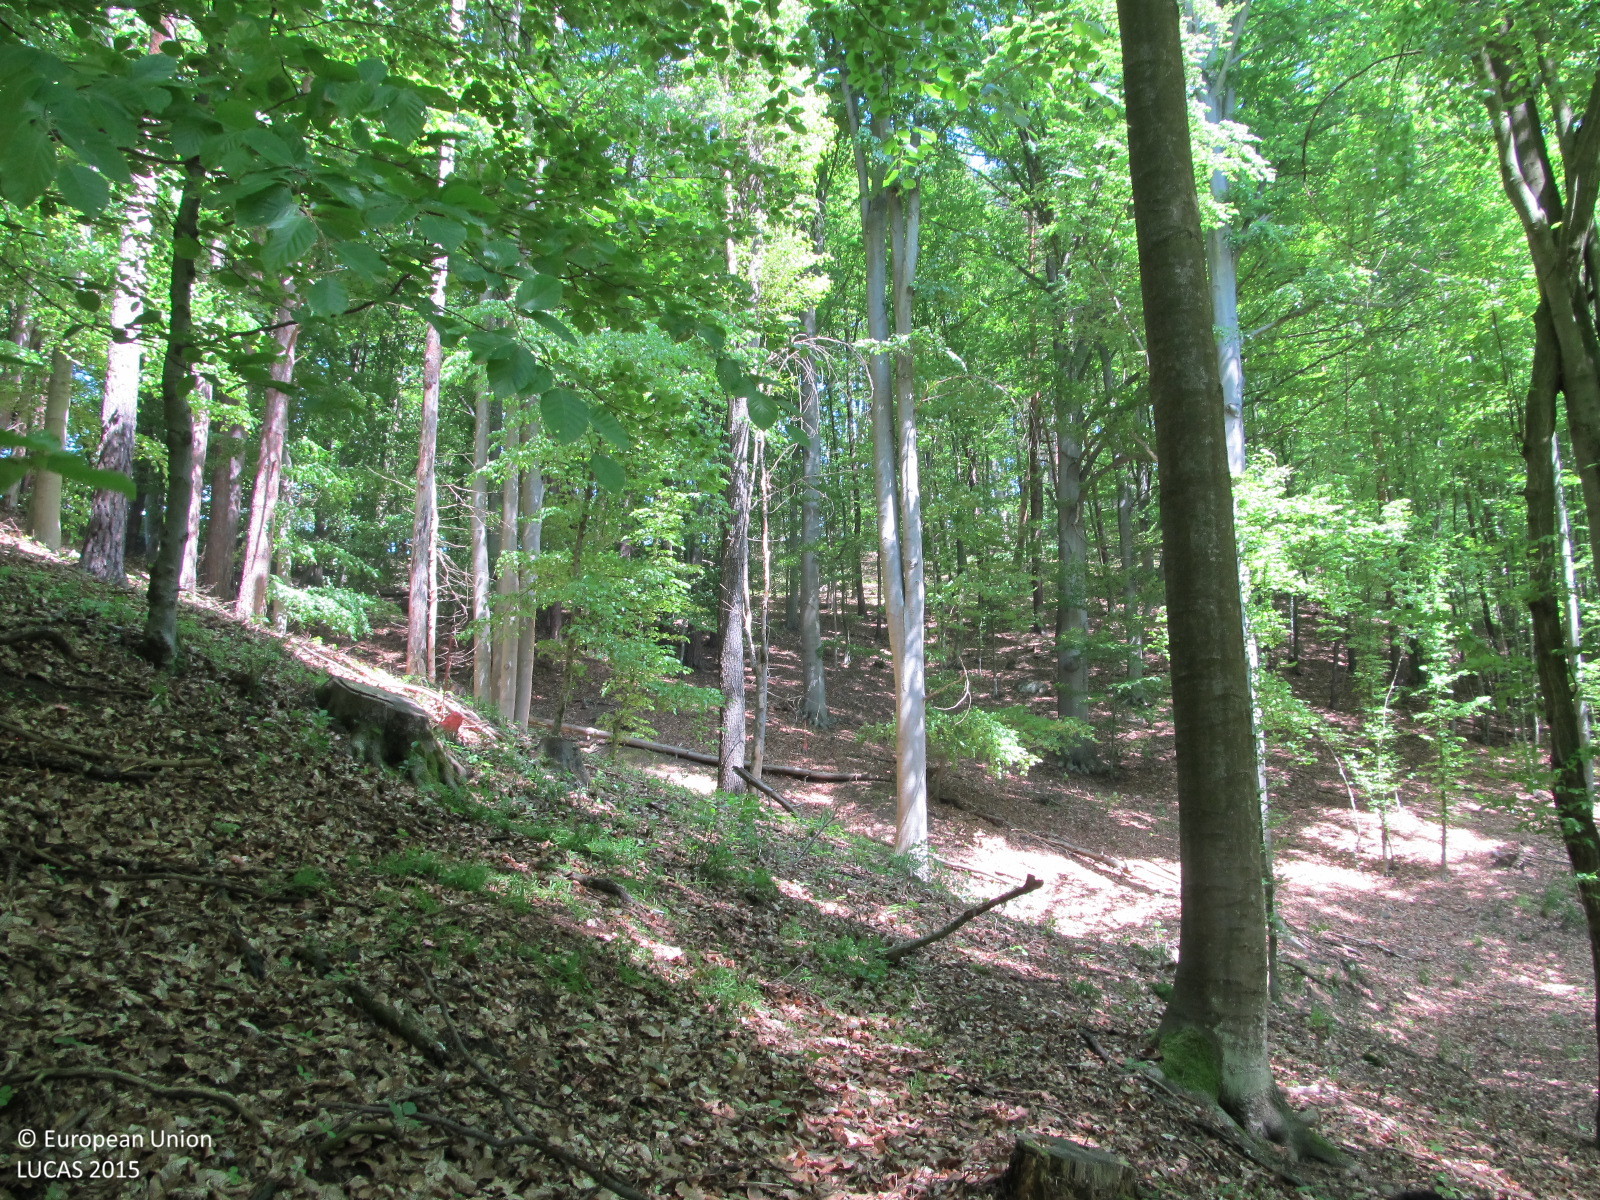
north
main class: Woodland
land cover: Pine dominated mixed woodland
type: beech forest
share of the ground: > 75 %
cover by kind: broadleaved forest trees 60 %, coniferous forest trees 20 %, herbaceous plants 10 %, shrubs 5 %, unconsolidated bare surface 5 %
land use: Forestry
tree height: > 5 m
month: May
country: AT
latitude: 48.5019
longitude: 15.4841
